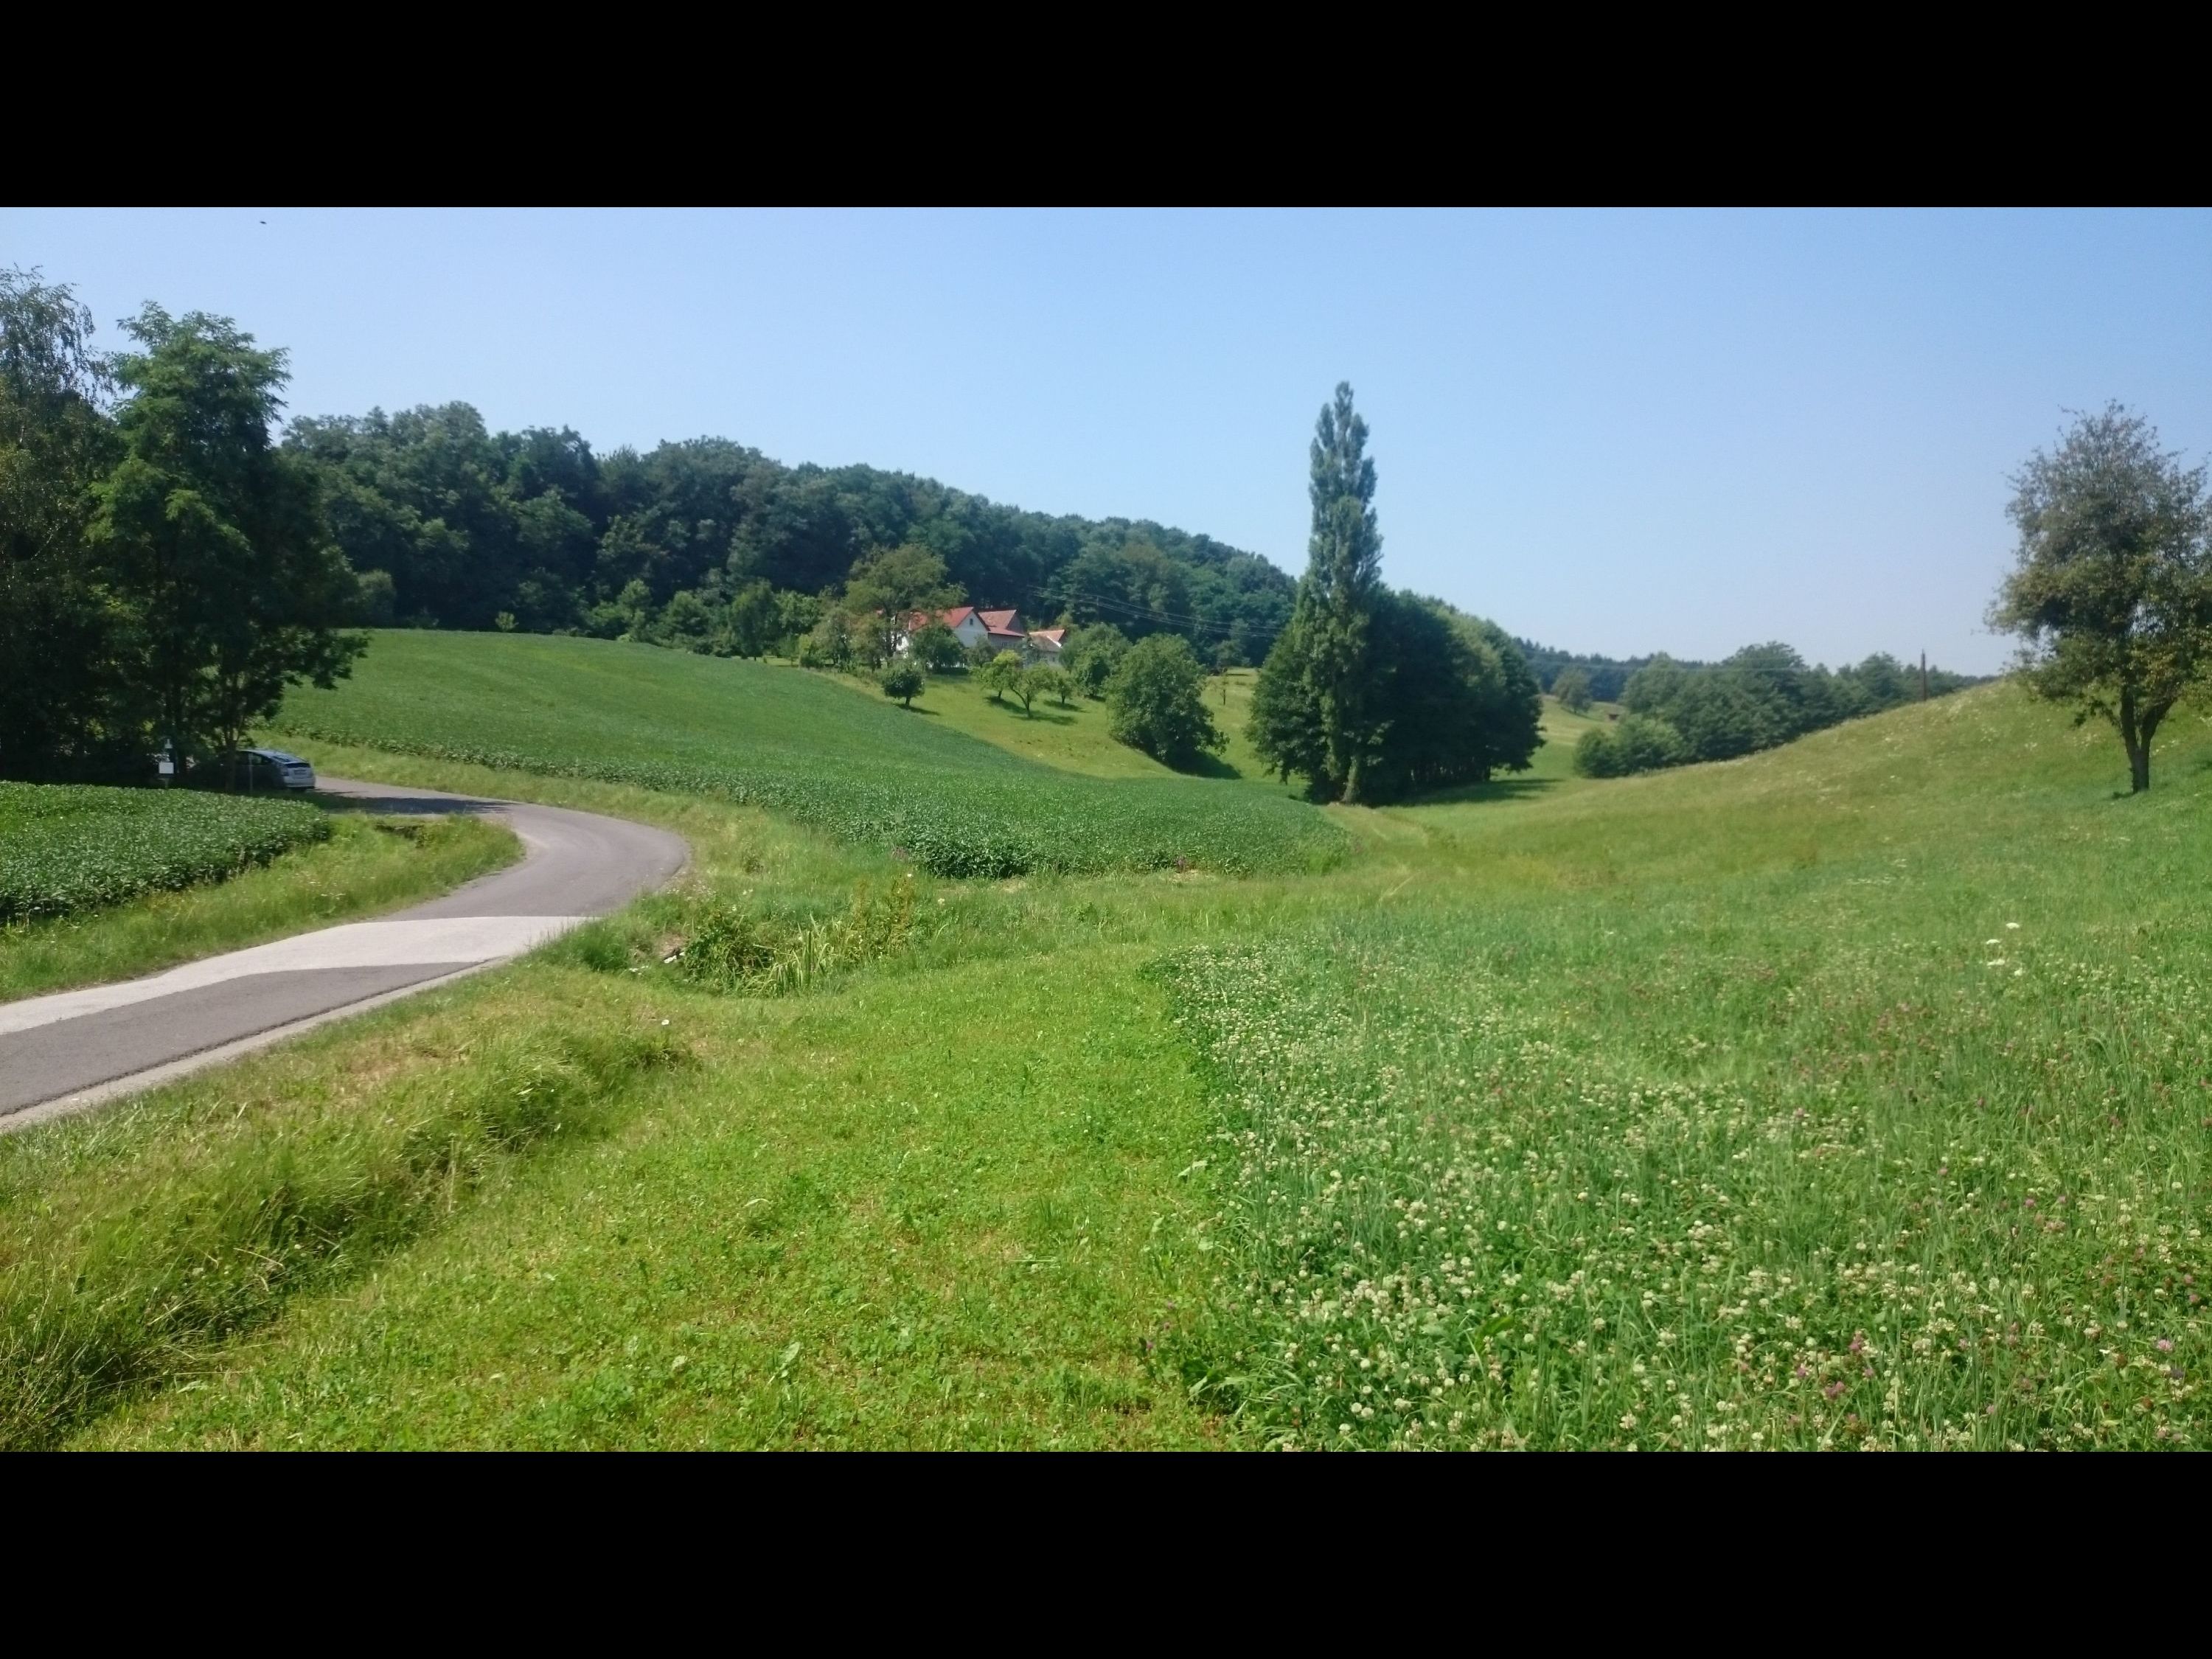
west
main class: Cropland
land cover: Clovers
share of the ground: > 75 %
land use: Agriculture (excluding fallow land and kitchen gardens)
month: July
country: AT
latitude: 47.0082
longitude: 16.0912
